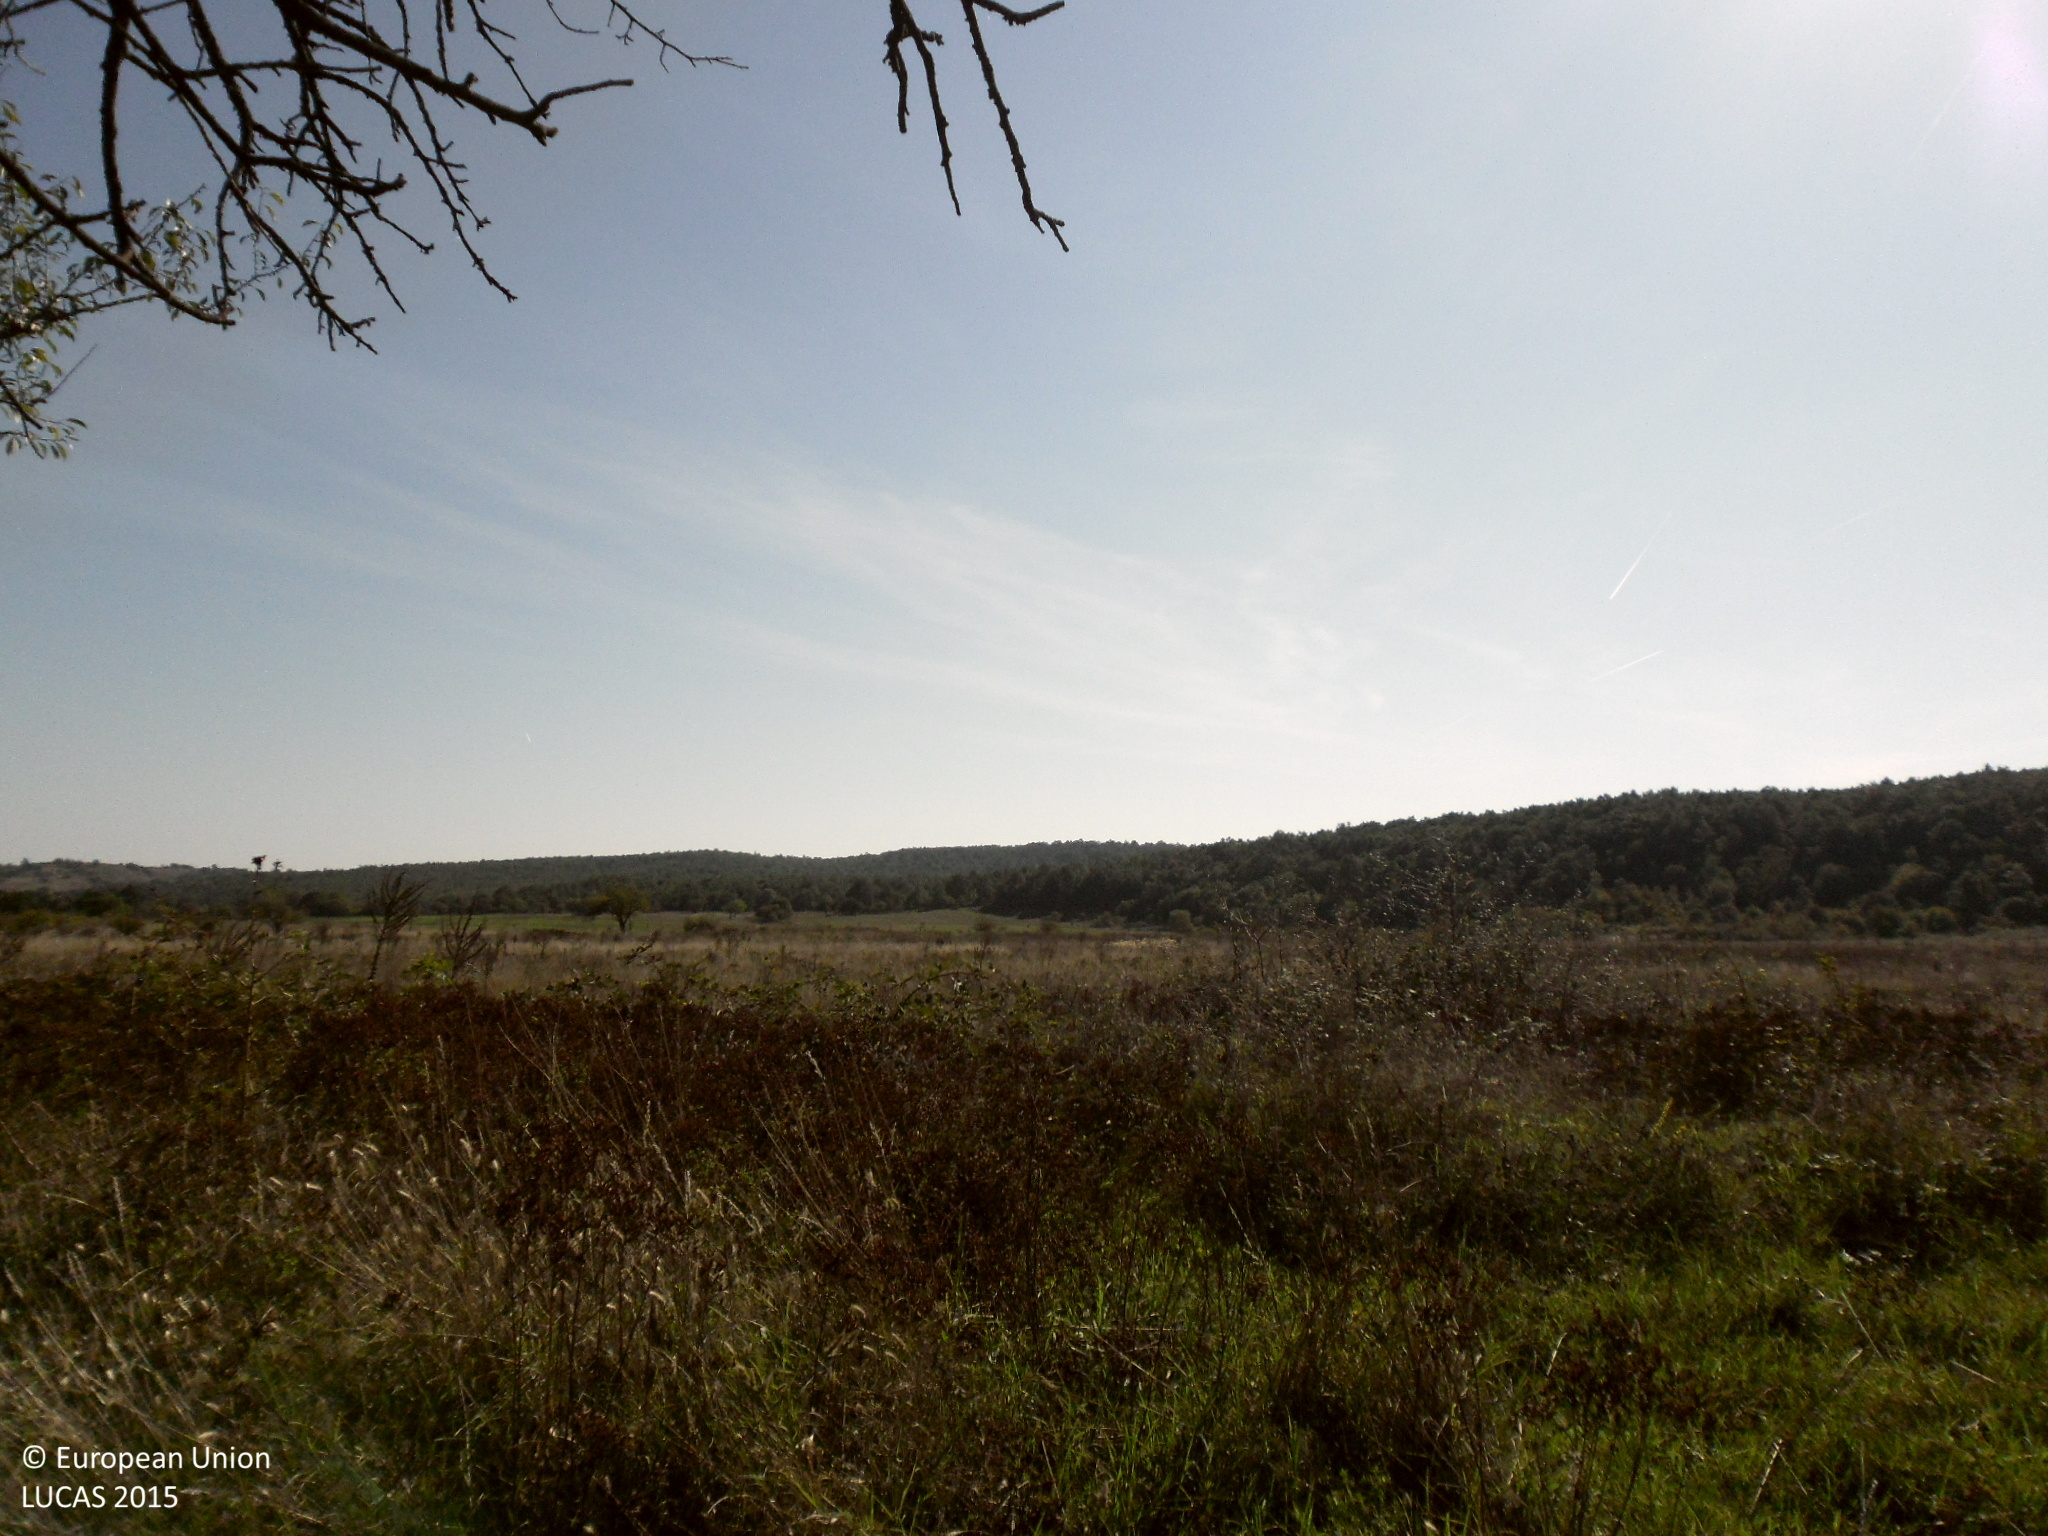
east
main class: Grassland
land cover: Grassland with sparse tree/shrub cover
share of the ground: > 75 %
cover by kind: herbaceous plants 90 %, broadleaved forest trees 5 %, shrubs 5 %
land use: Agriculture (excluding fallow land and kitchen gardens)
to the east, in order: Grassland with sparse tree/shrub cover; Grassland without tree/shrub cover; Single bushes/trees; Grassland without tree/shrub cover; Abandoned hedges; Grassland without tree/shrub cover
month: October
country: BG
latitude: 43.6078
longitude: 22.8090
